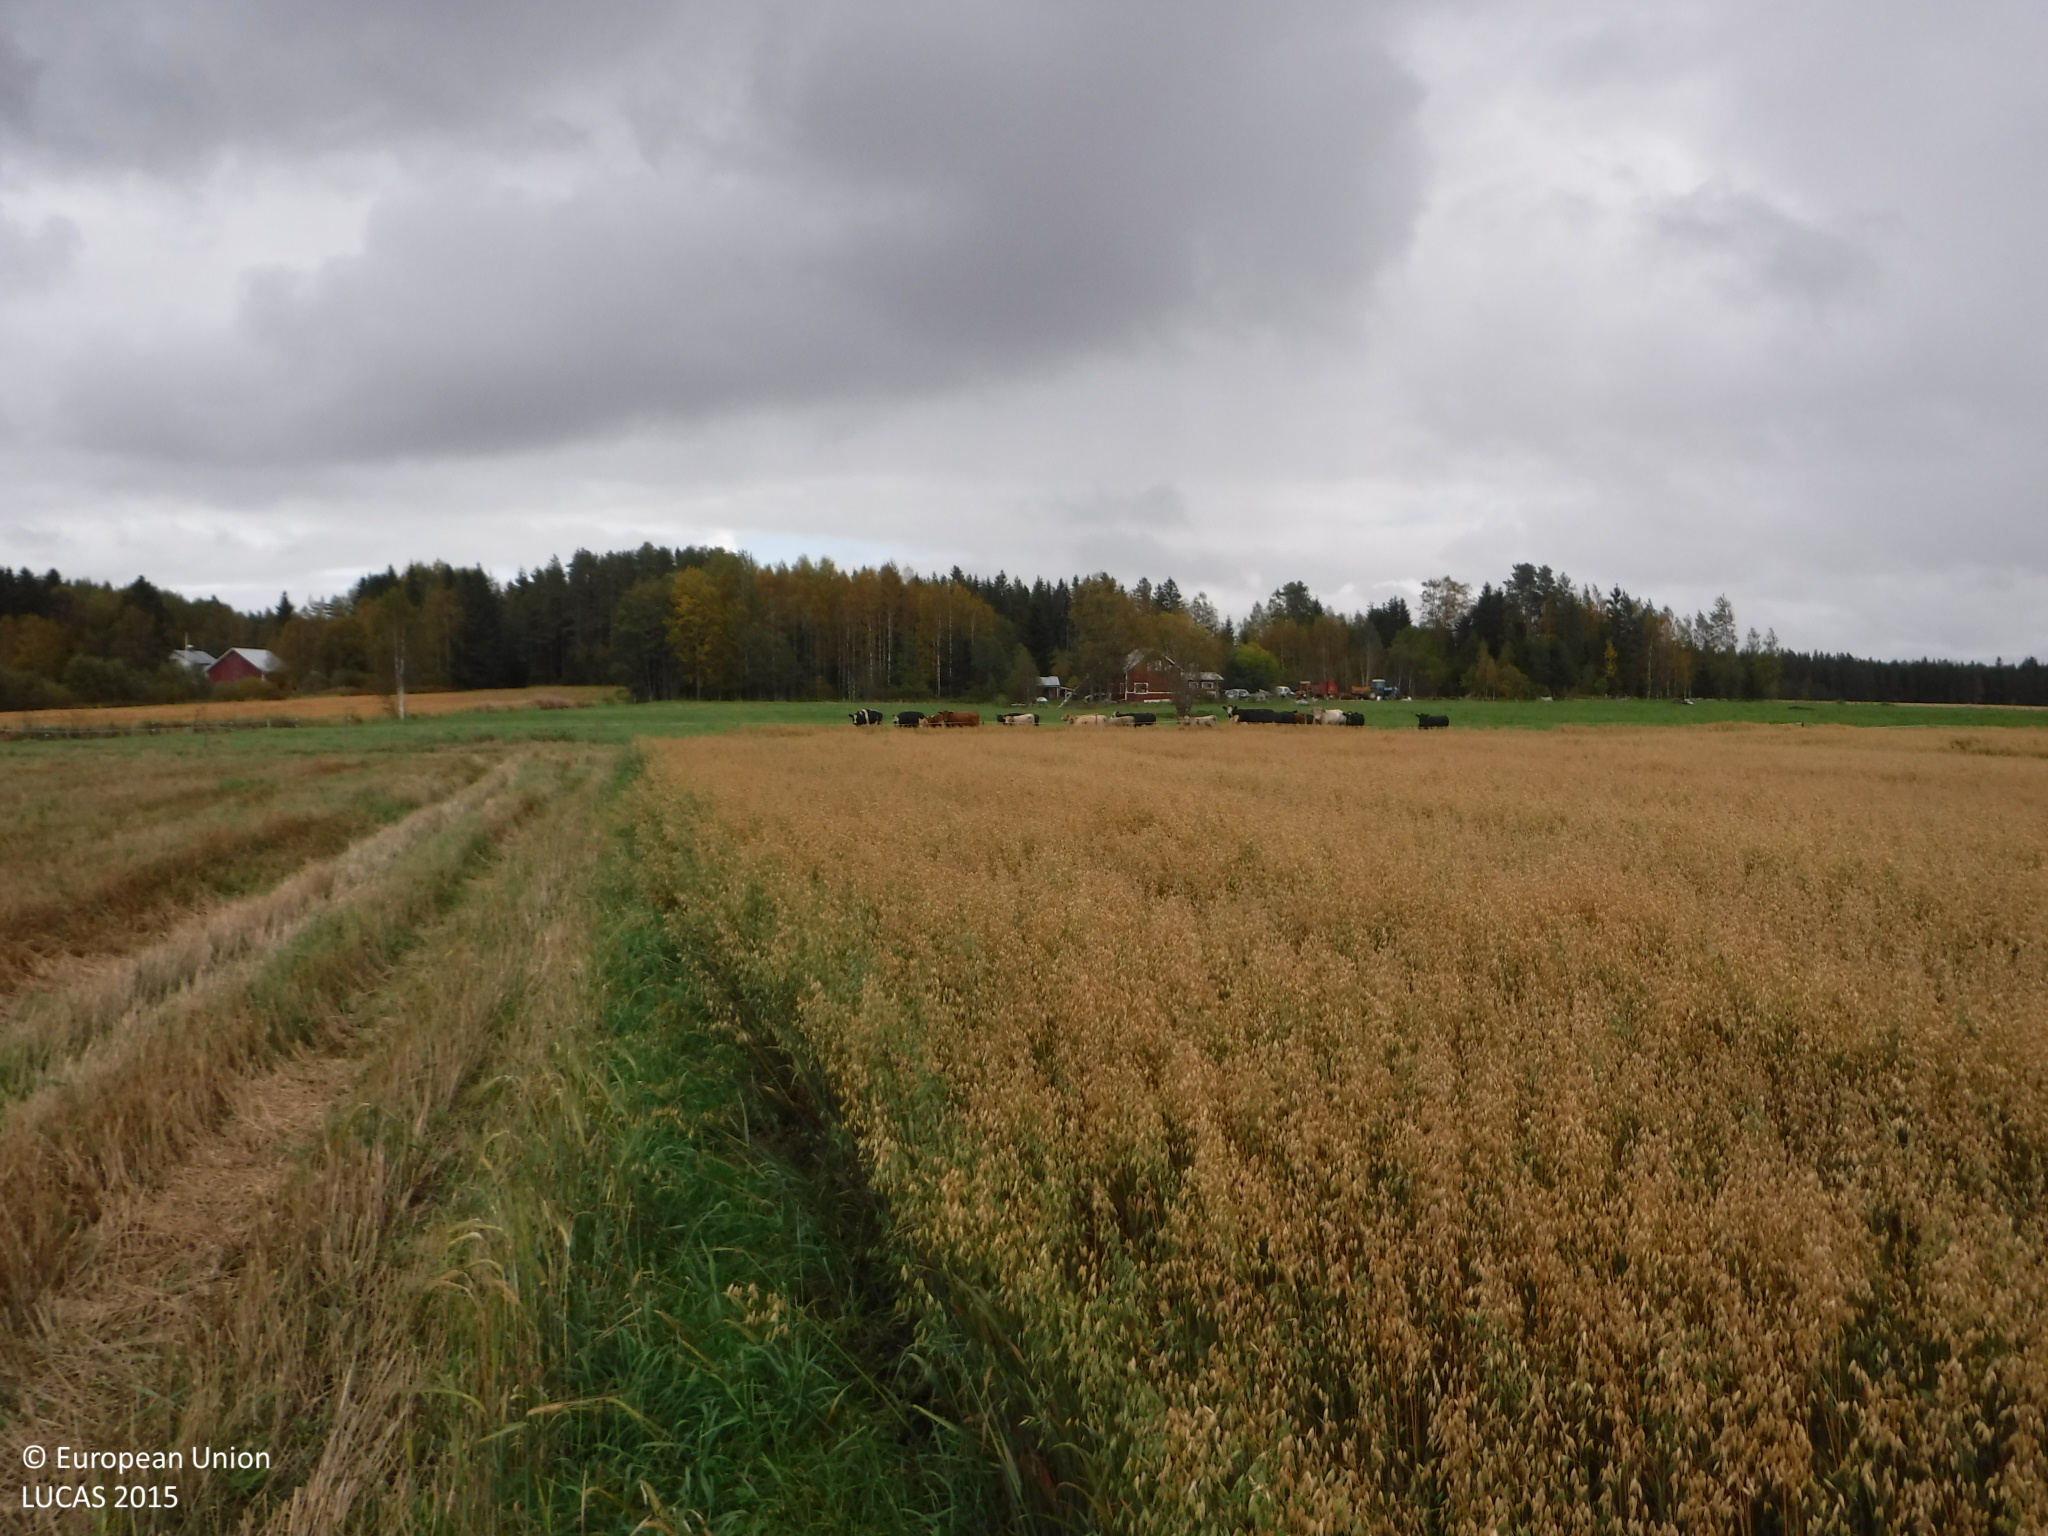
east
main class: Cropland
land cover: Oats
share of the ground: > 75 %
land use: Agriculture (excluding fallow land and kitchen gardens)
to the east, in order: Oats; Grass margins; Ditches and canals; Grass margins; Fences; Grassland without tree/shrub cover; Single bushes/trees; Grassland without tree/shrub cover; Fences; Broadleaved woodland; Artificial constructions in urban areas; Ditches and canals; Spruce dominated mixed woodland; Broadleaved woodland
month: September
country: FI
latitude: 62.0528
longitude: 22.2783
